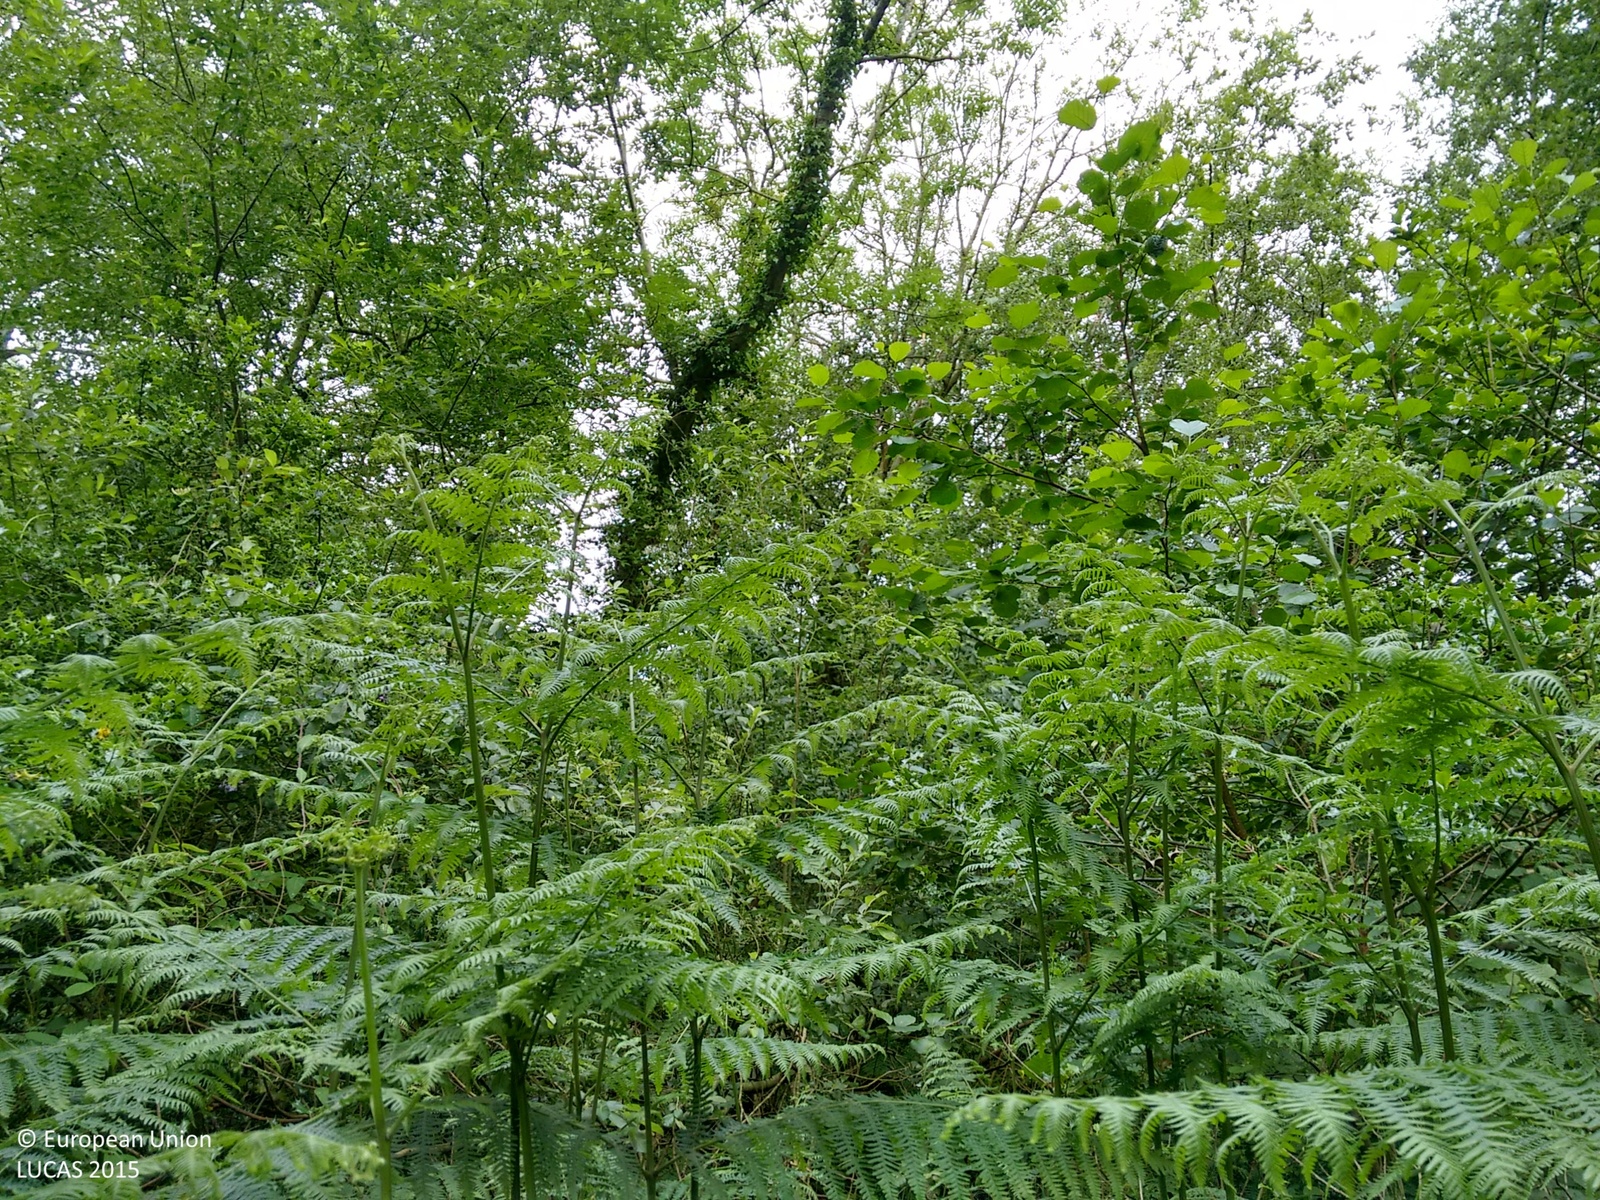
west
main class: Woodland
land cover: Broadleaved woodland
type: acidophilous oak and oak-birch forest
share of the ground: > 75 %
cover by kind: broadleaved forest trees 100 %
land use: Semi-natural and natural areas not in use
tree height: > 5 m
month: July
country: GB
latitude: 54.9735
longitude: -3.5325
